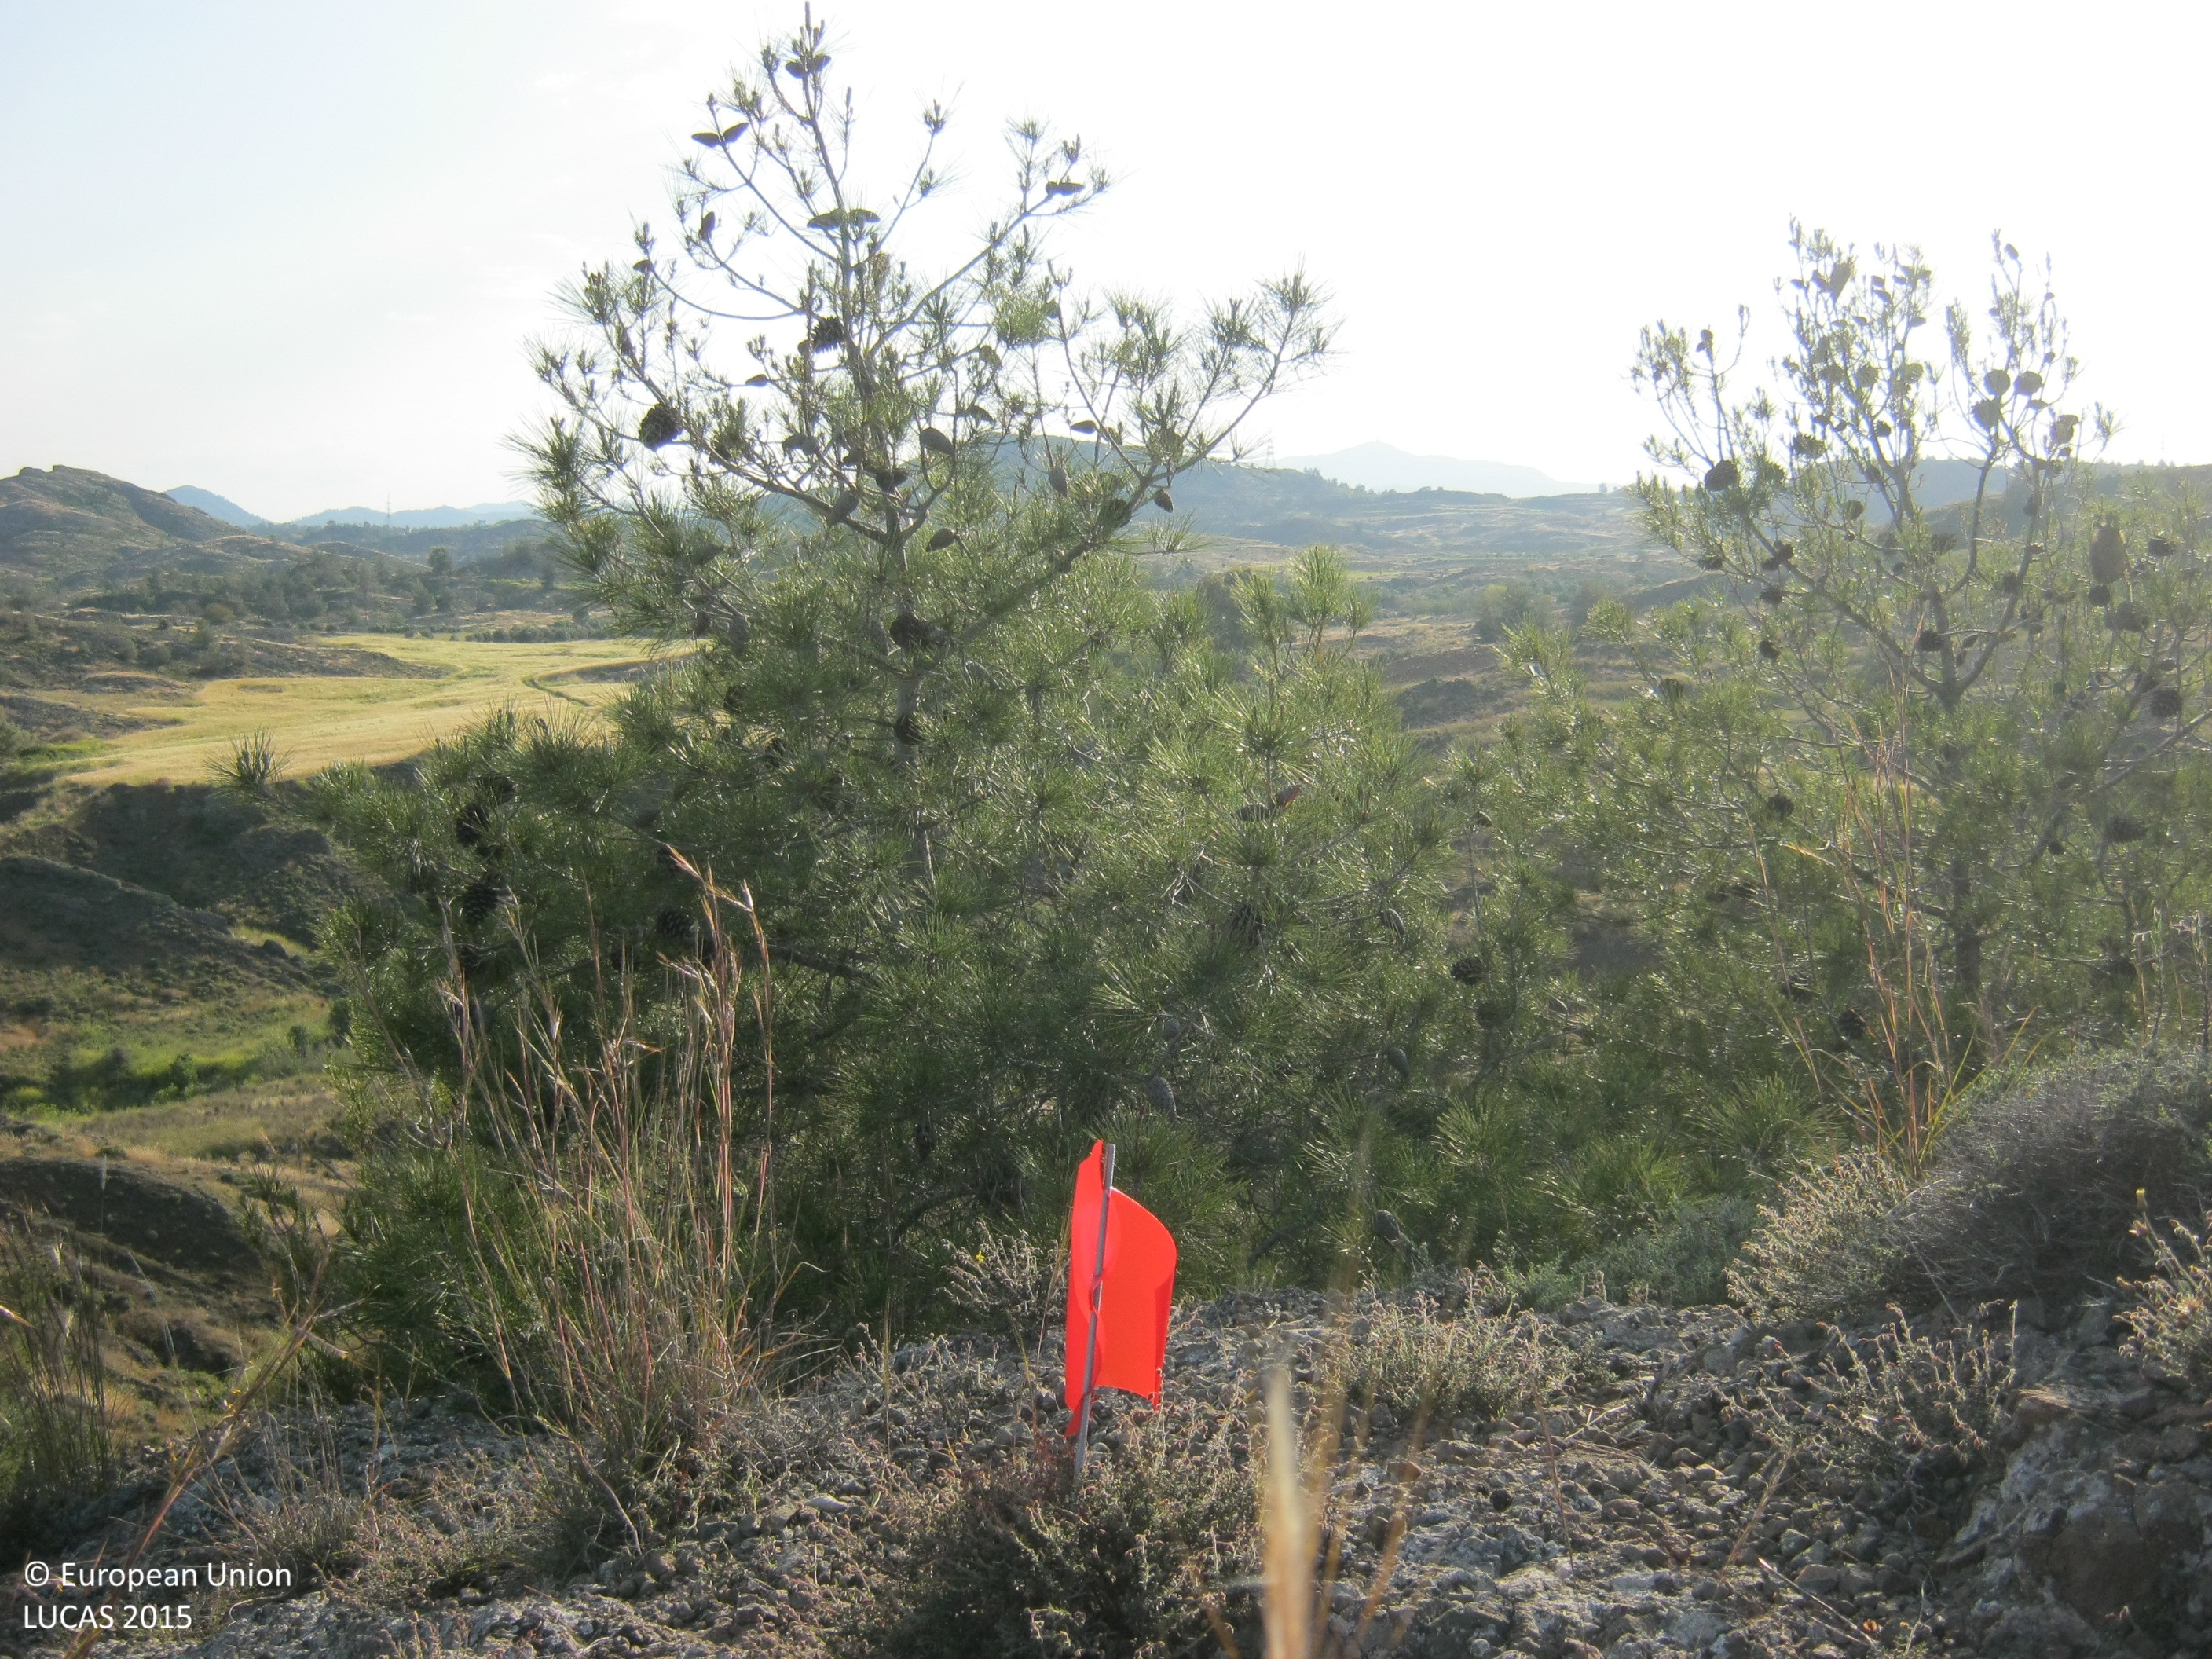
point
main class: Shrubland
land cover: Shrubland without tree cover
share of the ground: 25 - 50 %
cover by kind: unconsolidated bare surface 30 %, shrubs 25 %, herbaceous plants 25 %, consolidated bare surface 20 %
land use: Semi-natural and natural areas not in use
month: April
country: CY
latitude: 34.9781
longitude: 33.3775
